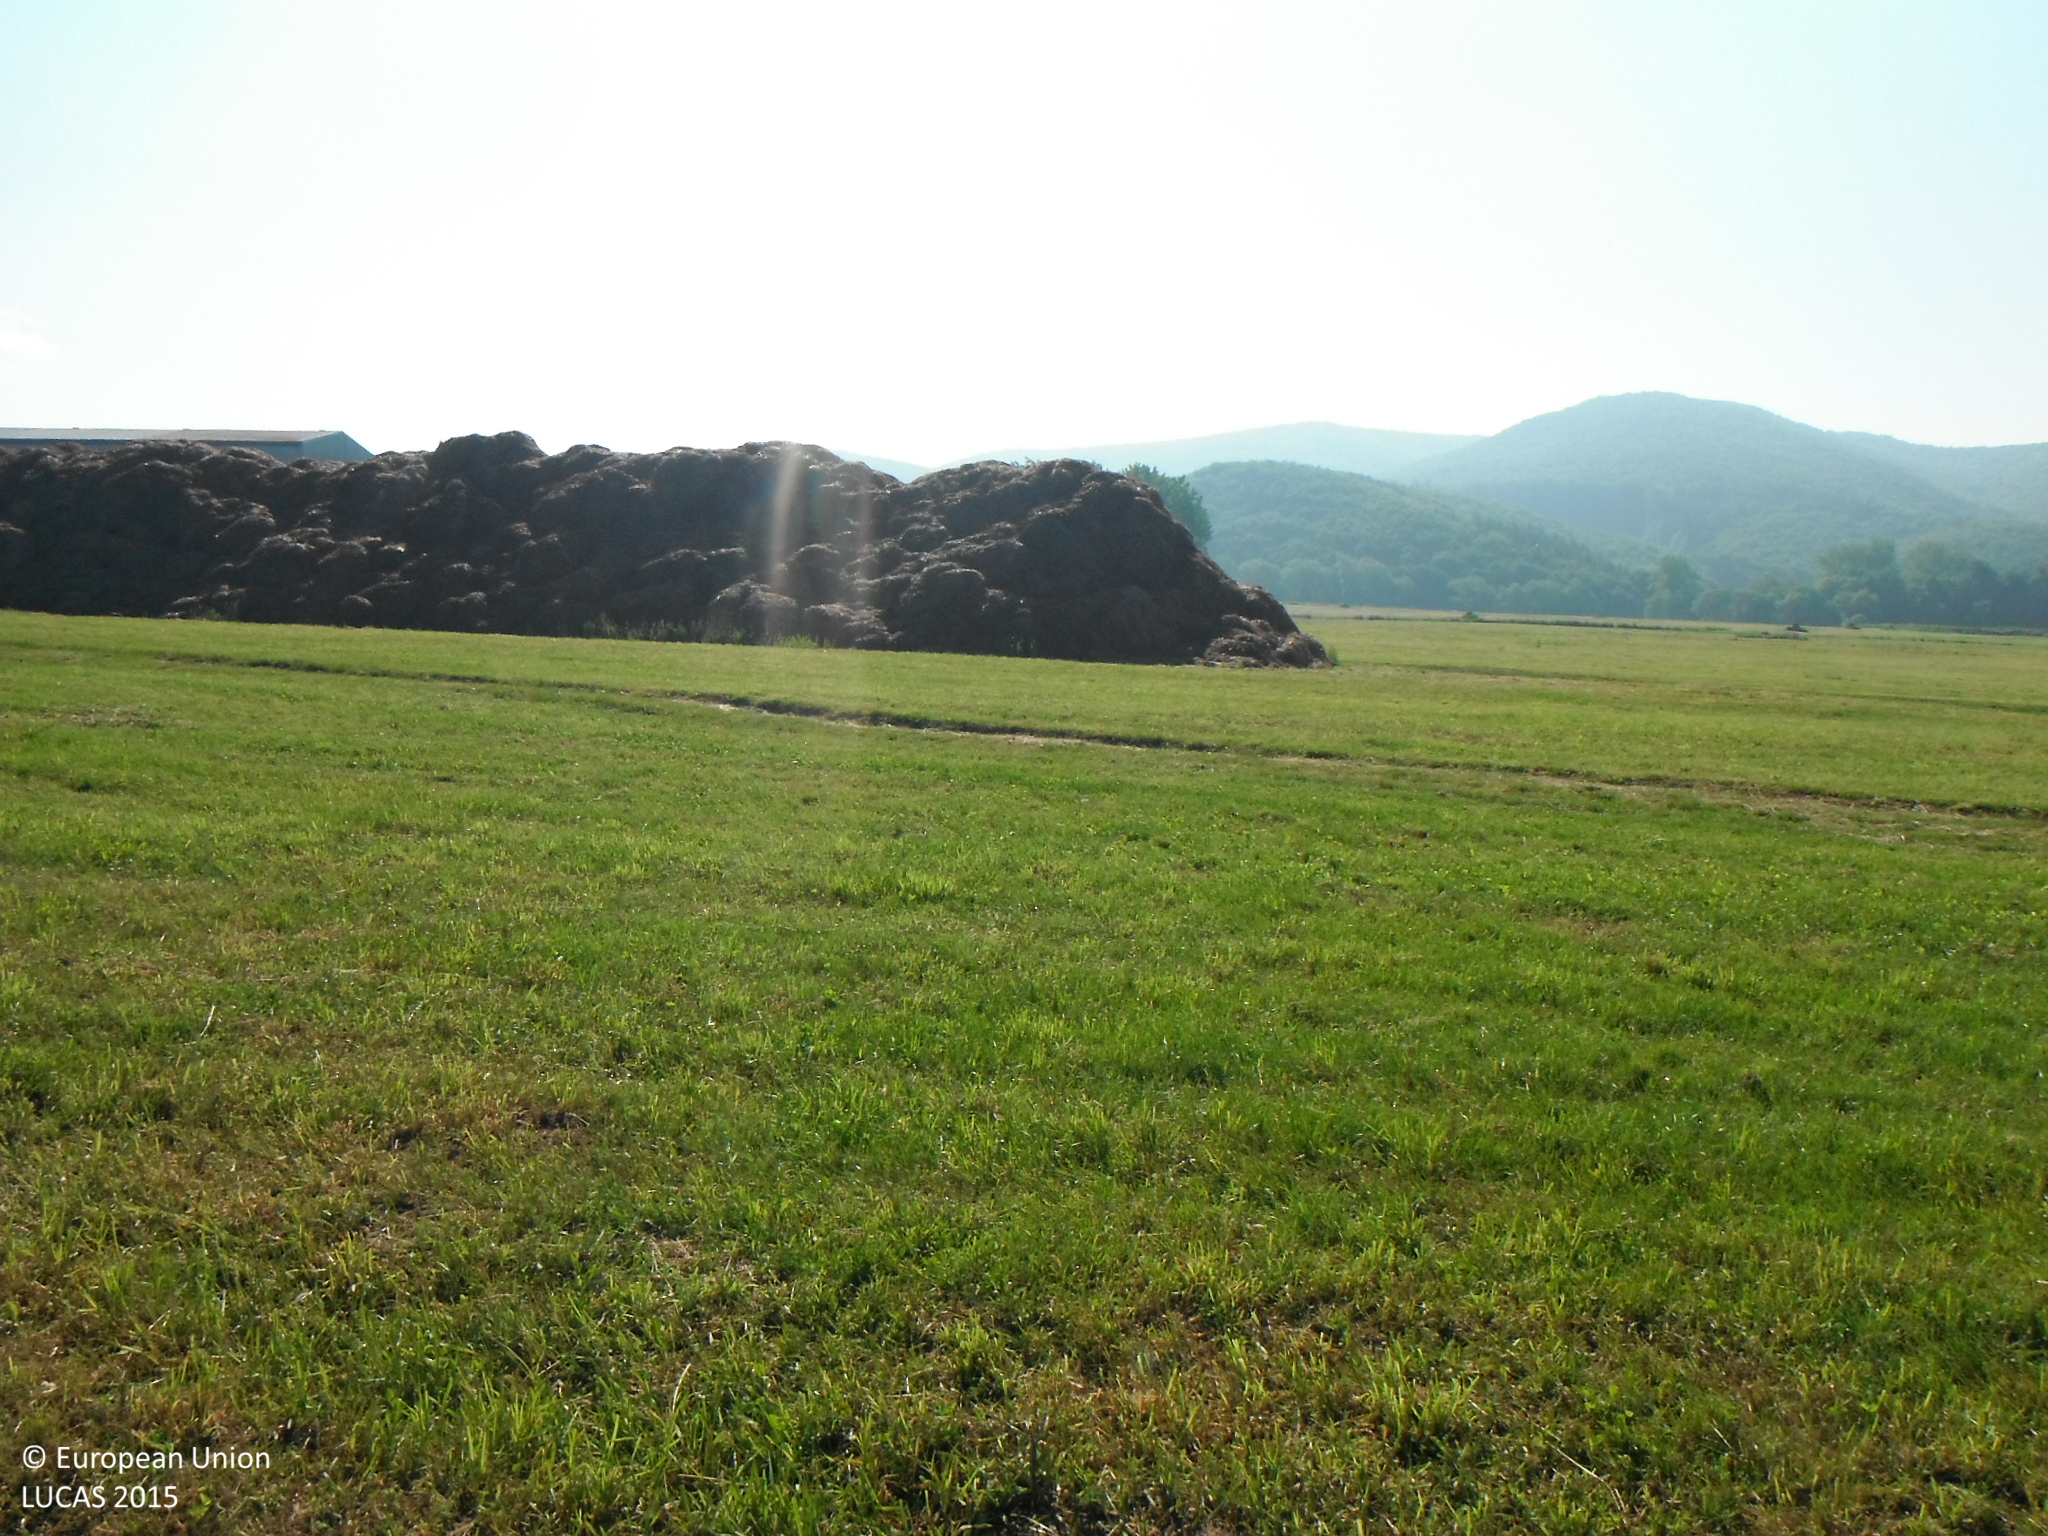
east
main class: Grassland
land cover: Grassland without tree/shrub cover
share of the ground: > 75 %
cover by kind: herbaceous plants 100 %
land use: Agriculture (excluding fallow land and kitchen gardens)
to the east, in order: Grassland without tree/shrub cover; Tracks; Grassland without tree/shrub cover; Tracks; Grassland without tree/shrub cover; Artificial constructions in urban areas
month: June
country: SK
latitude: 48.5849
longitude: 19.3642
